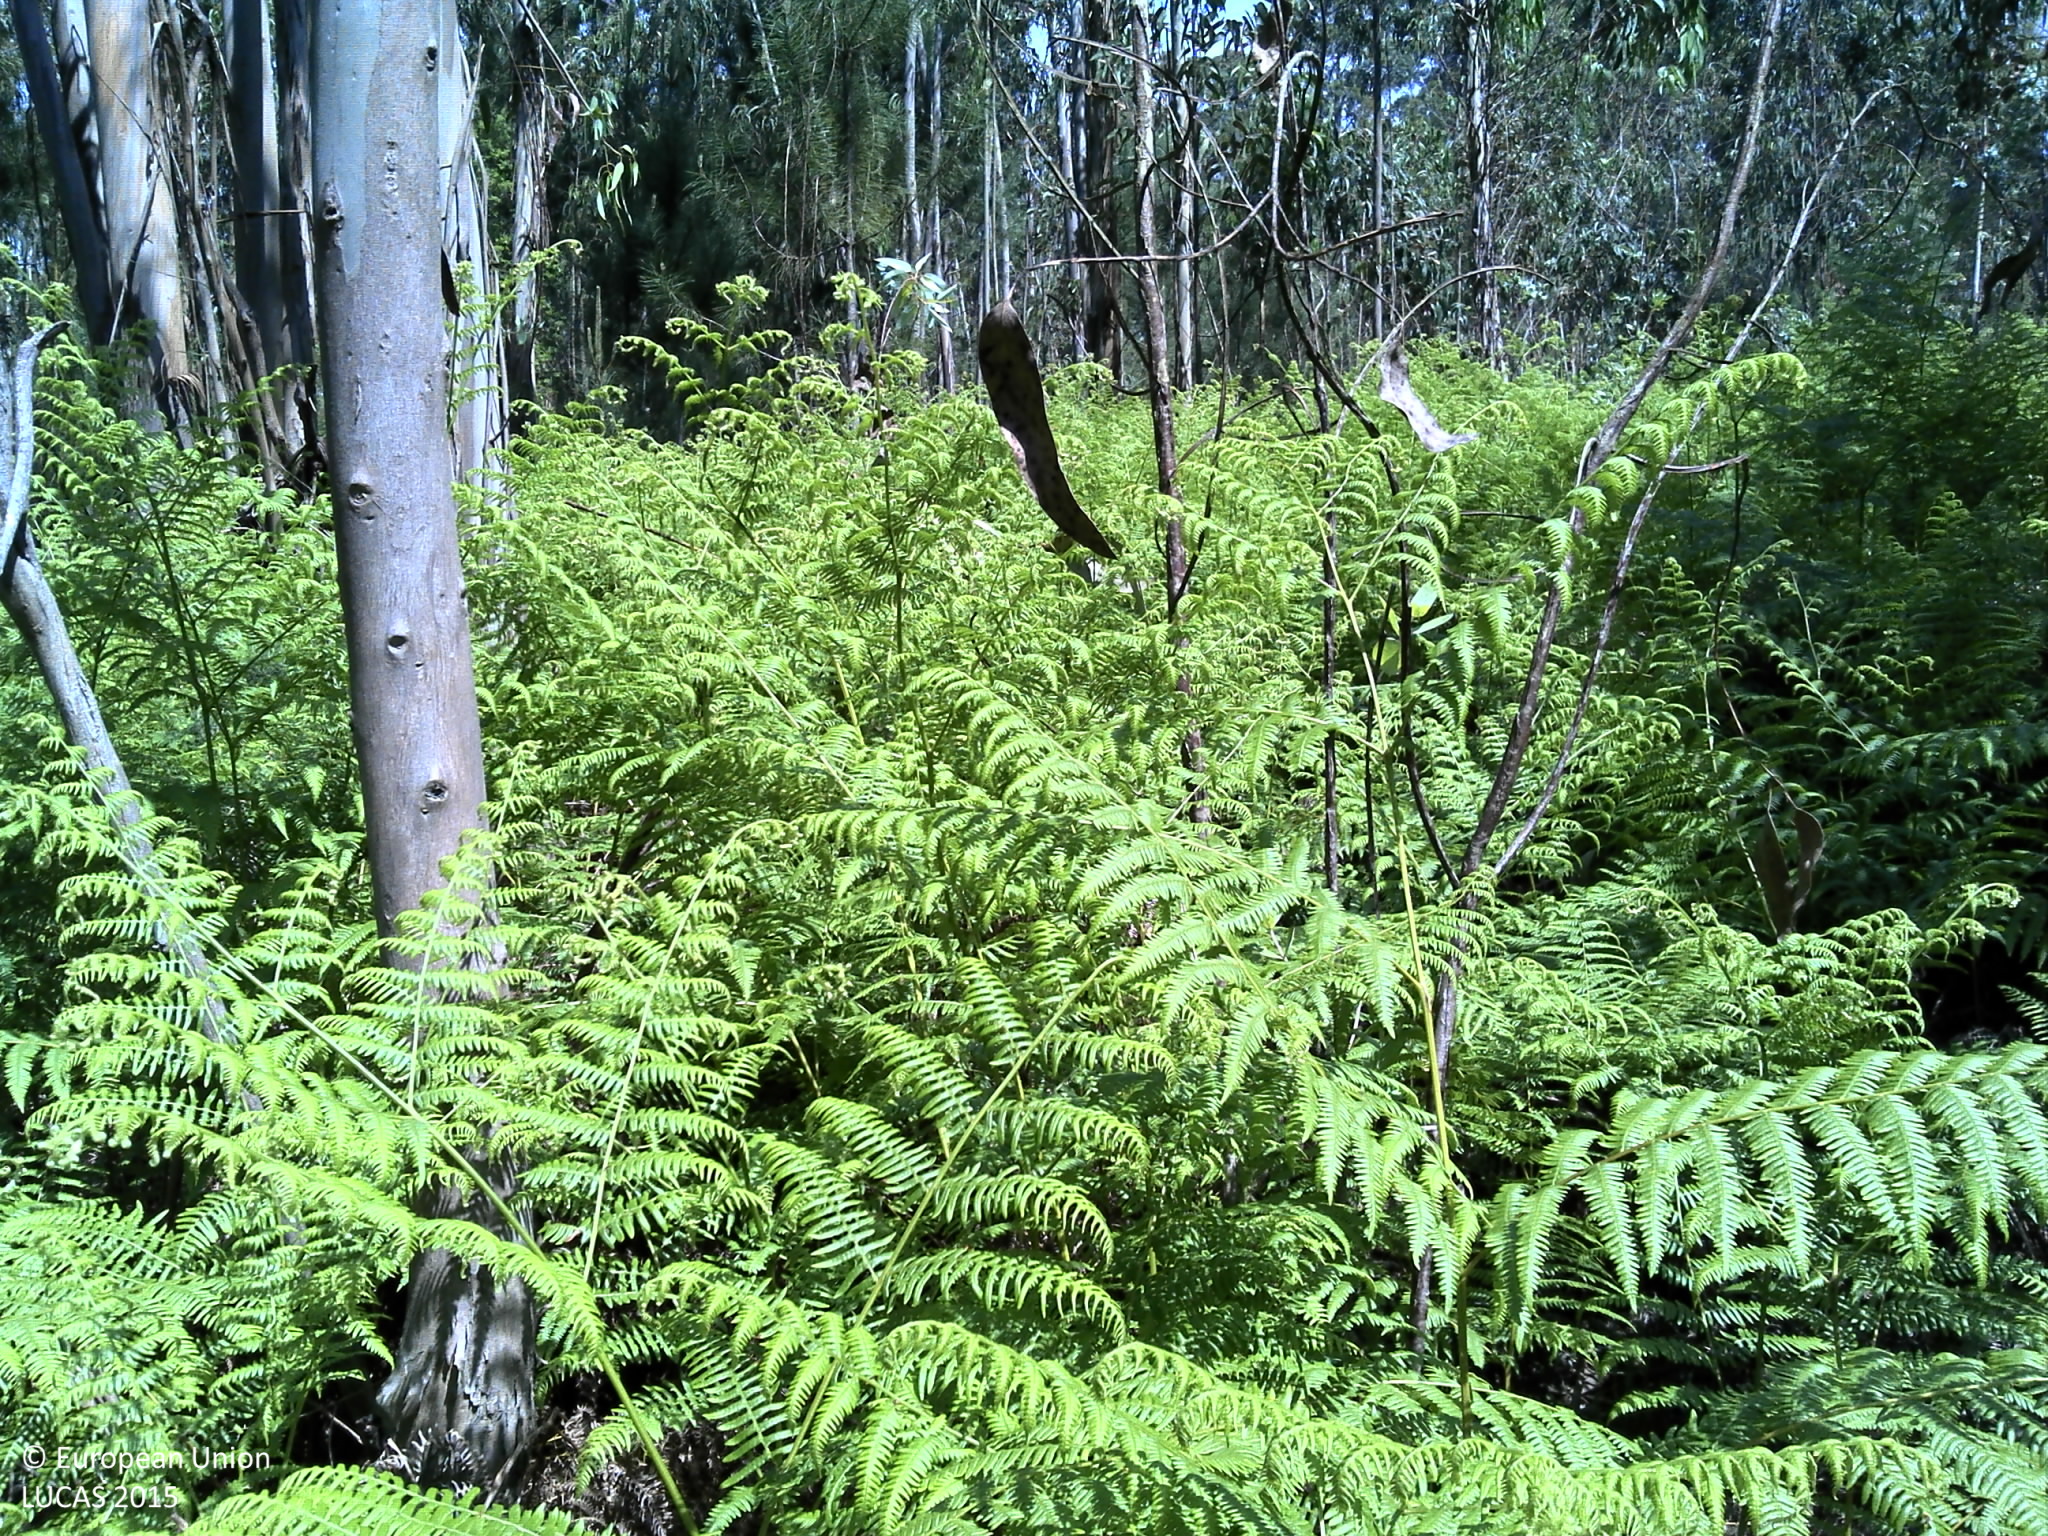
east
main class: Woodland
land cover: Broadleaved woodland
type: exotic forest
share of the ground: 50 - 75 %
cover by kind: broadleaved forest trees 70 %, shrubs 30 %
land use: Forestry
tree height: > 5 m
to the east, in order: Broadleaved woodland; Dry stone walls; Shrubland with sparse tree cover; Dry stone walls; Pine dominated coniferous woodland; Broadleaved woodland; Grassland with sparse tree/shrub cover; Broadleaved woodland
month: May
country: PT
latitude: 41.2564
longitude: -8.5441
